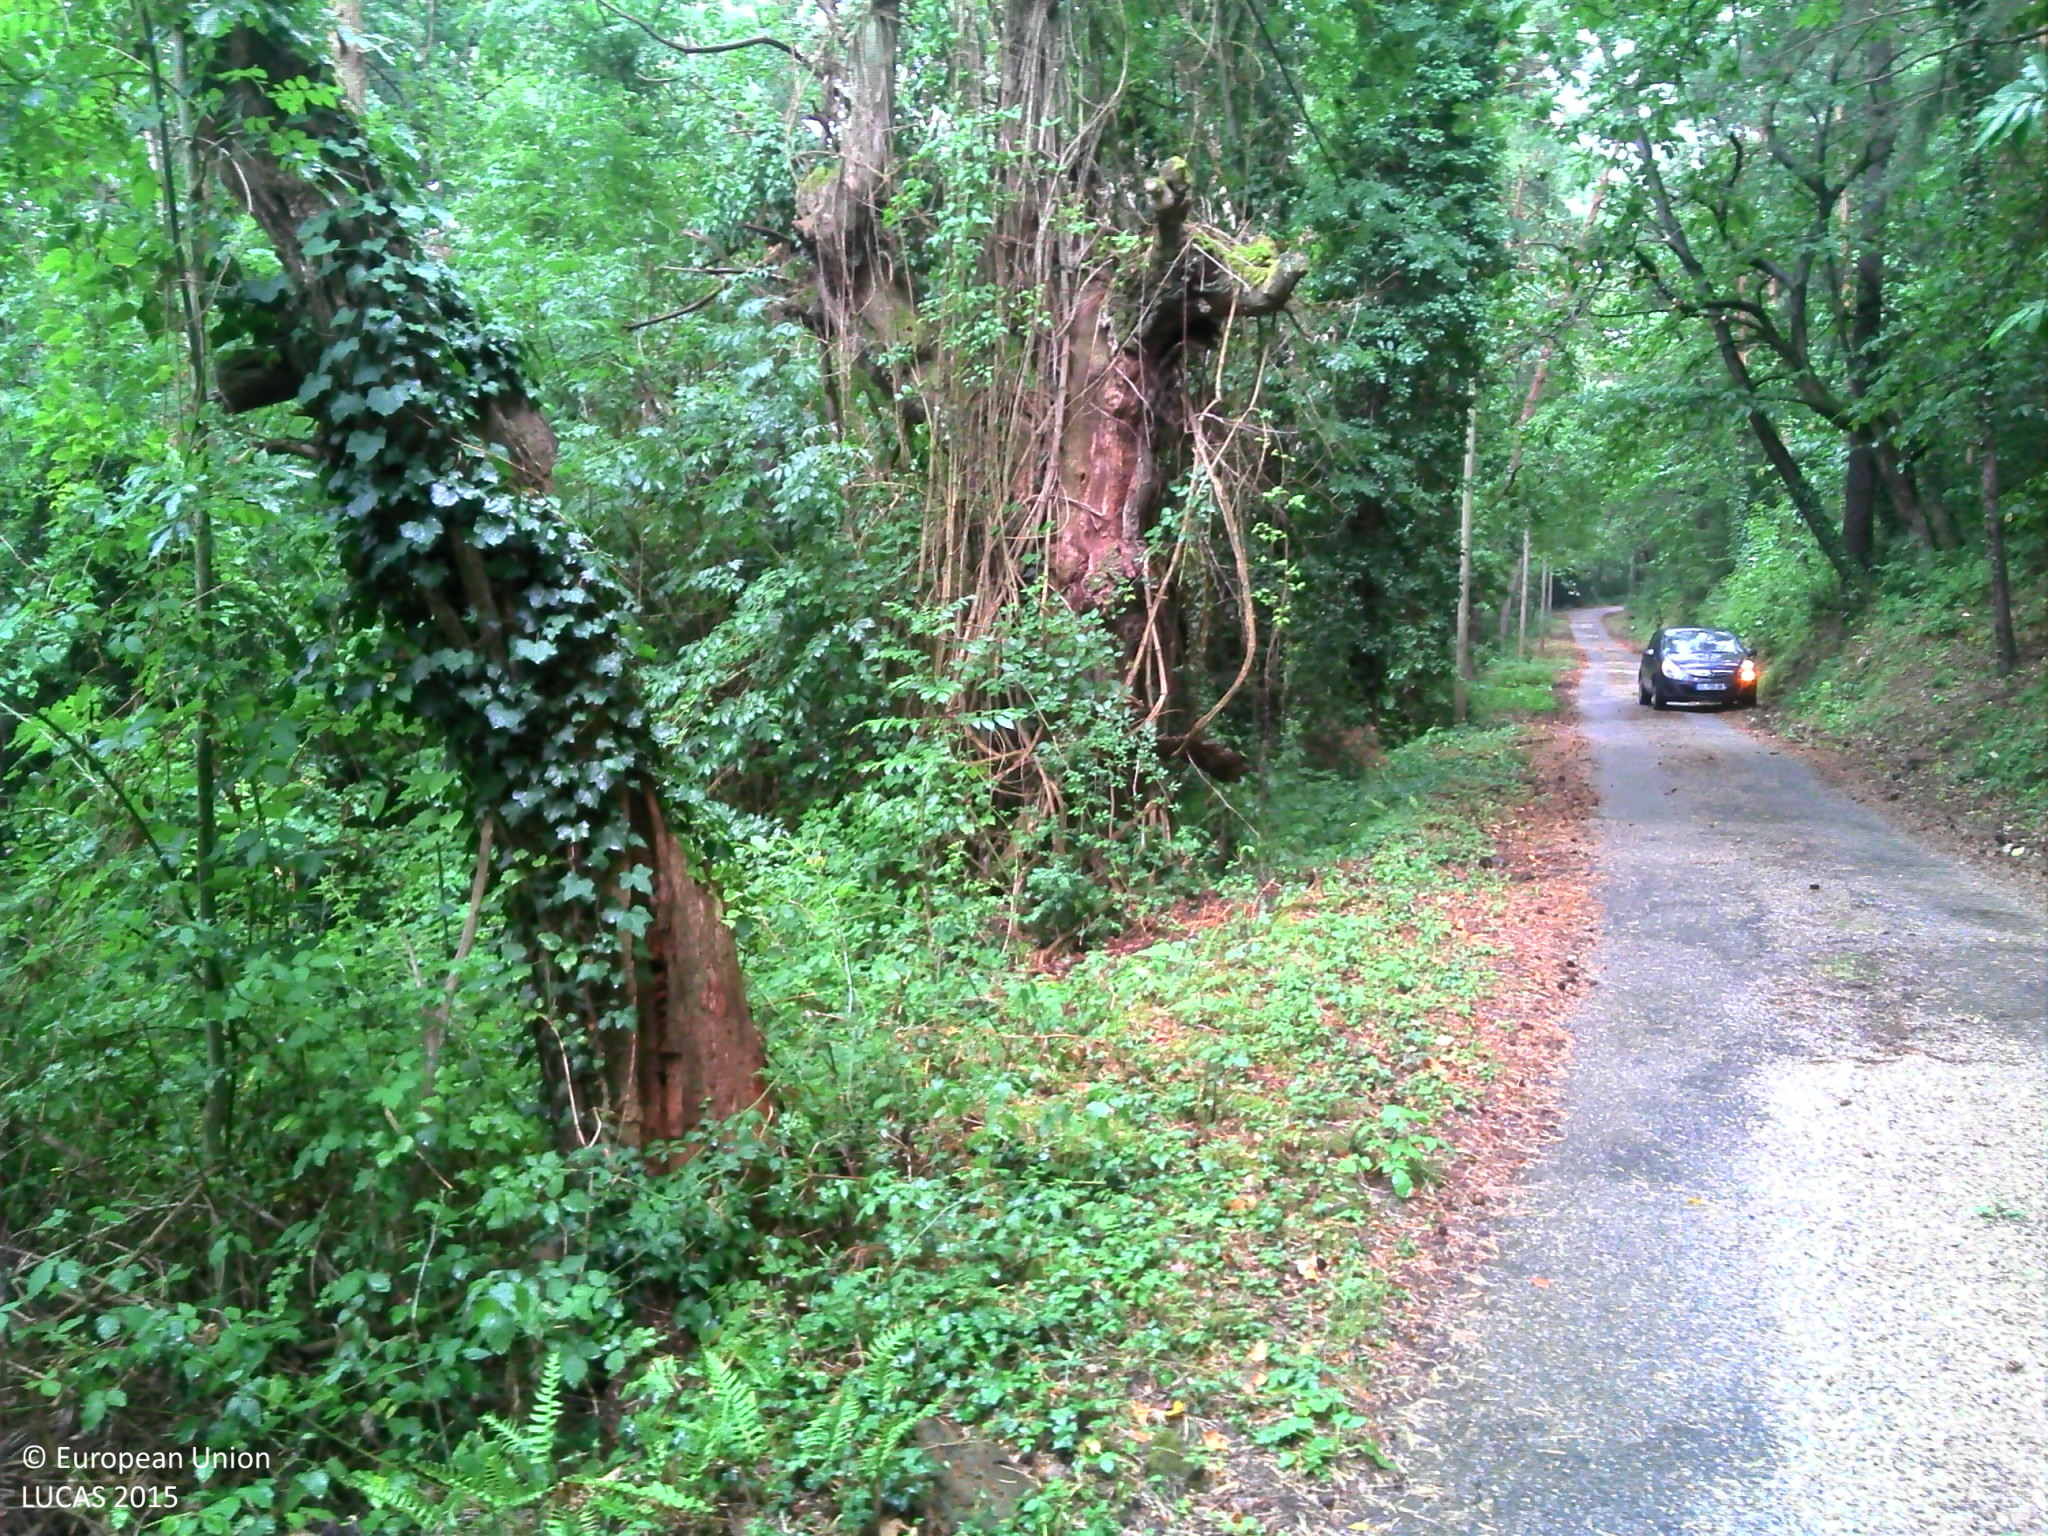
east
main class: Woodland
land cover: Pine dominated mixed woodland
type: mountainous beech forest
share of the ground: > 75 %
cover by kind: broadleaved forest trees 50 %, coniferous forest trees 25 %, herbaceous plants 25 %
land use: Semi-natural and natural areas not in use
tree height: > 5 m
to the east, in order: Paved roads, cycling and walking lanes; Electric lines; Pine dominated mixed woodland; Grassland without tree/shrub cover; Pine dominated mixed woodland; Grassland without tree/shrub cover
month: July
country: FR
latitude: 44.7887
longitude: 4.6089
